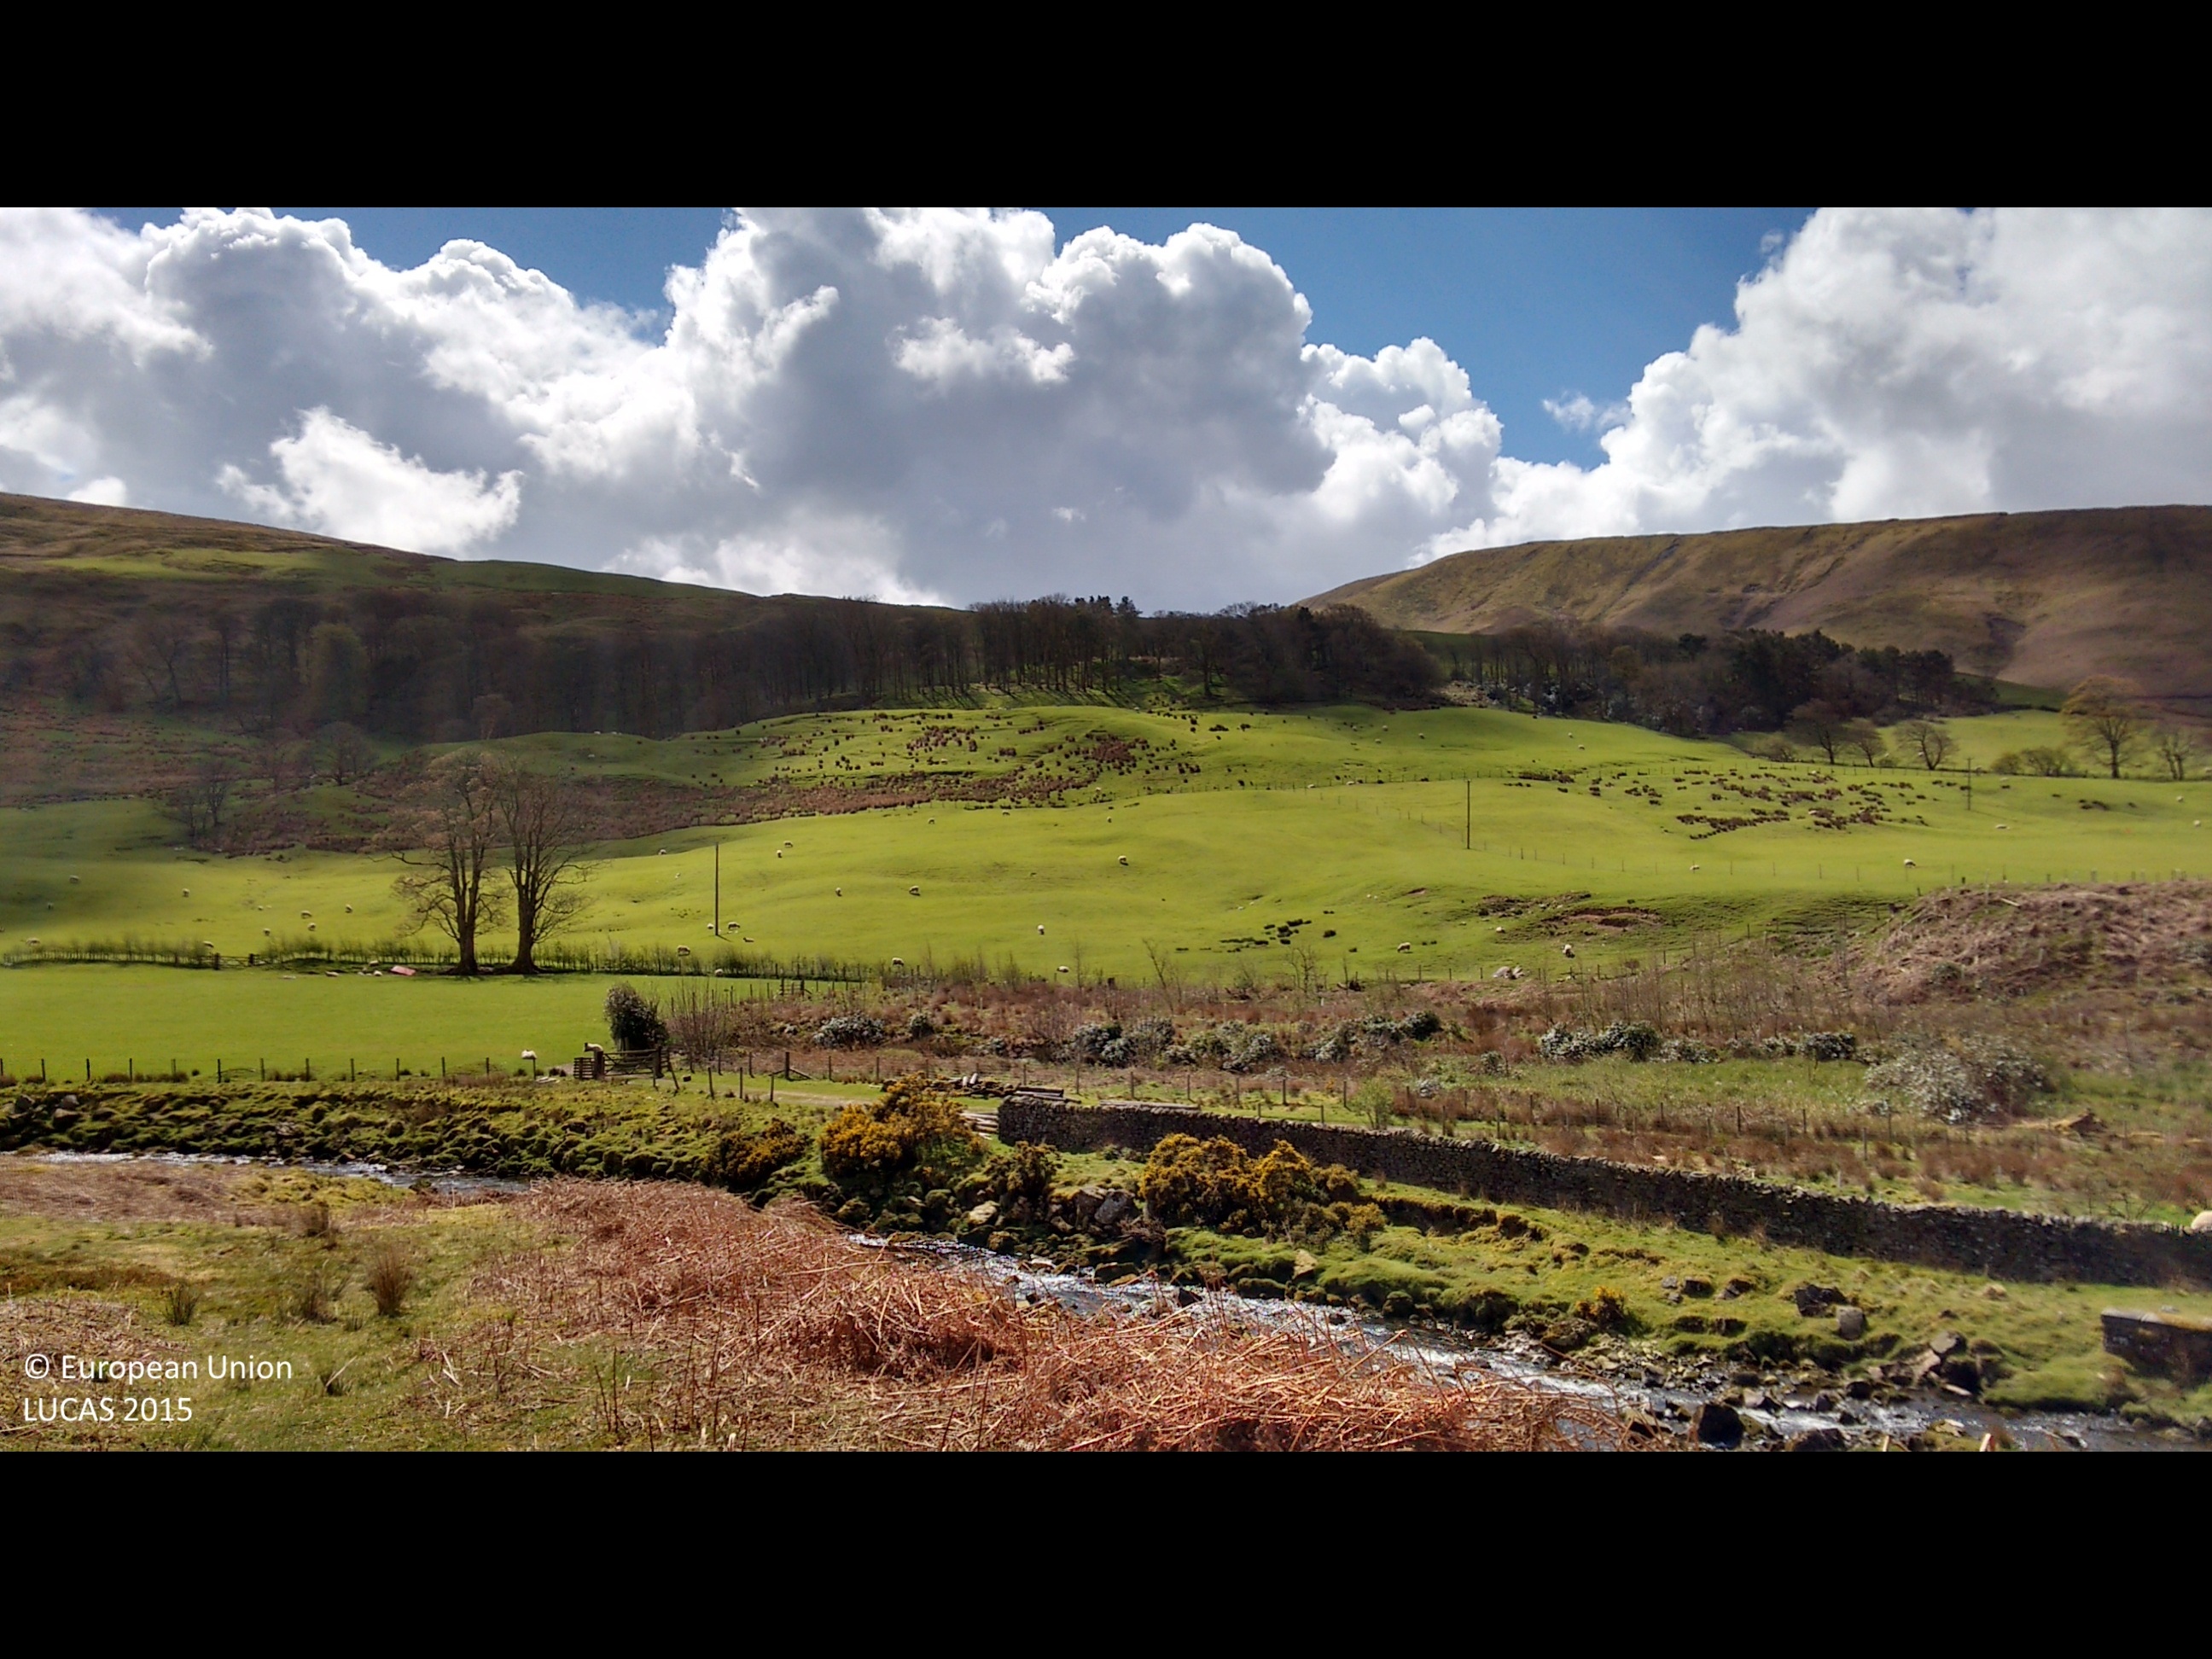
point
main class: Grassland
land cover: Grassland without tree/shrub cover
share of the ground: > 75 %
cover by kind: herbaceous plants 100 %
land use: Agriculture (excluding fallow land and kitchen gardens)
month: April
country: GB
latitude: 53.9480
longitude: -2.5444
